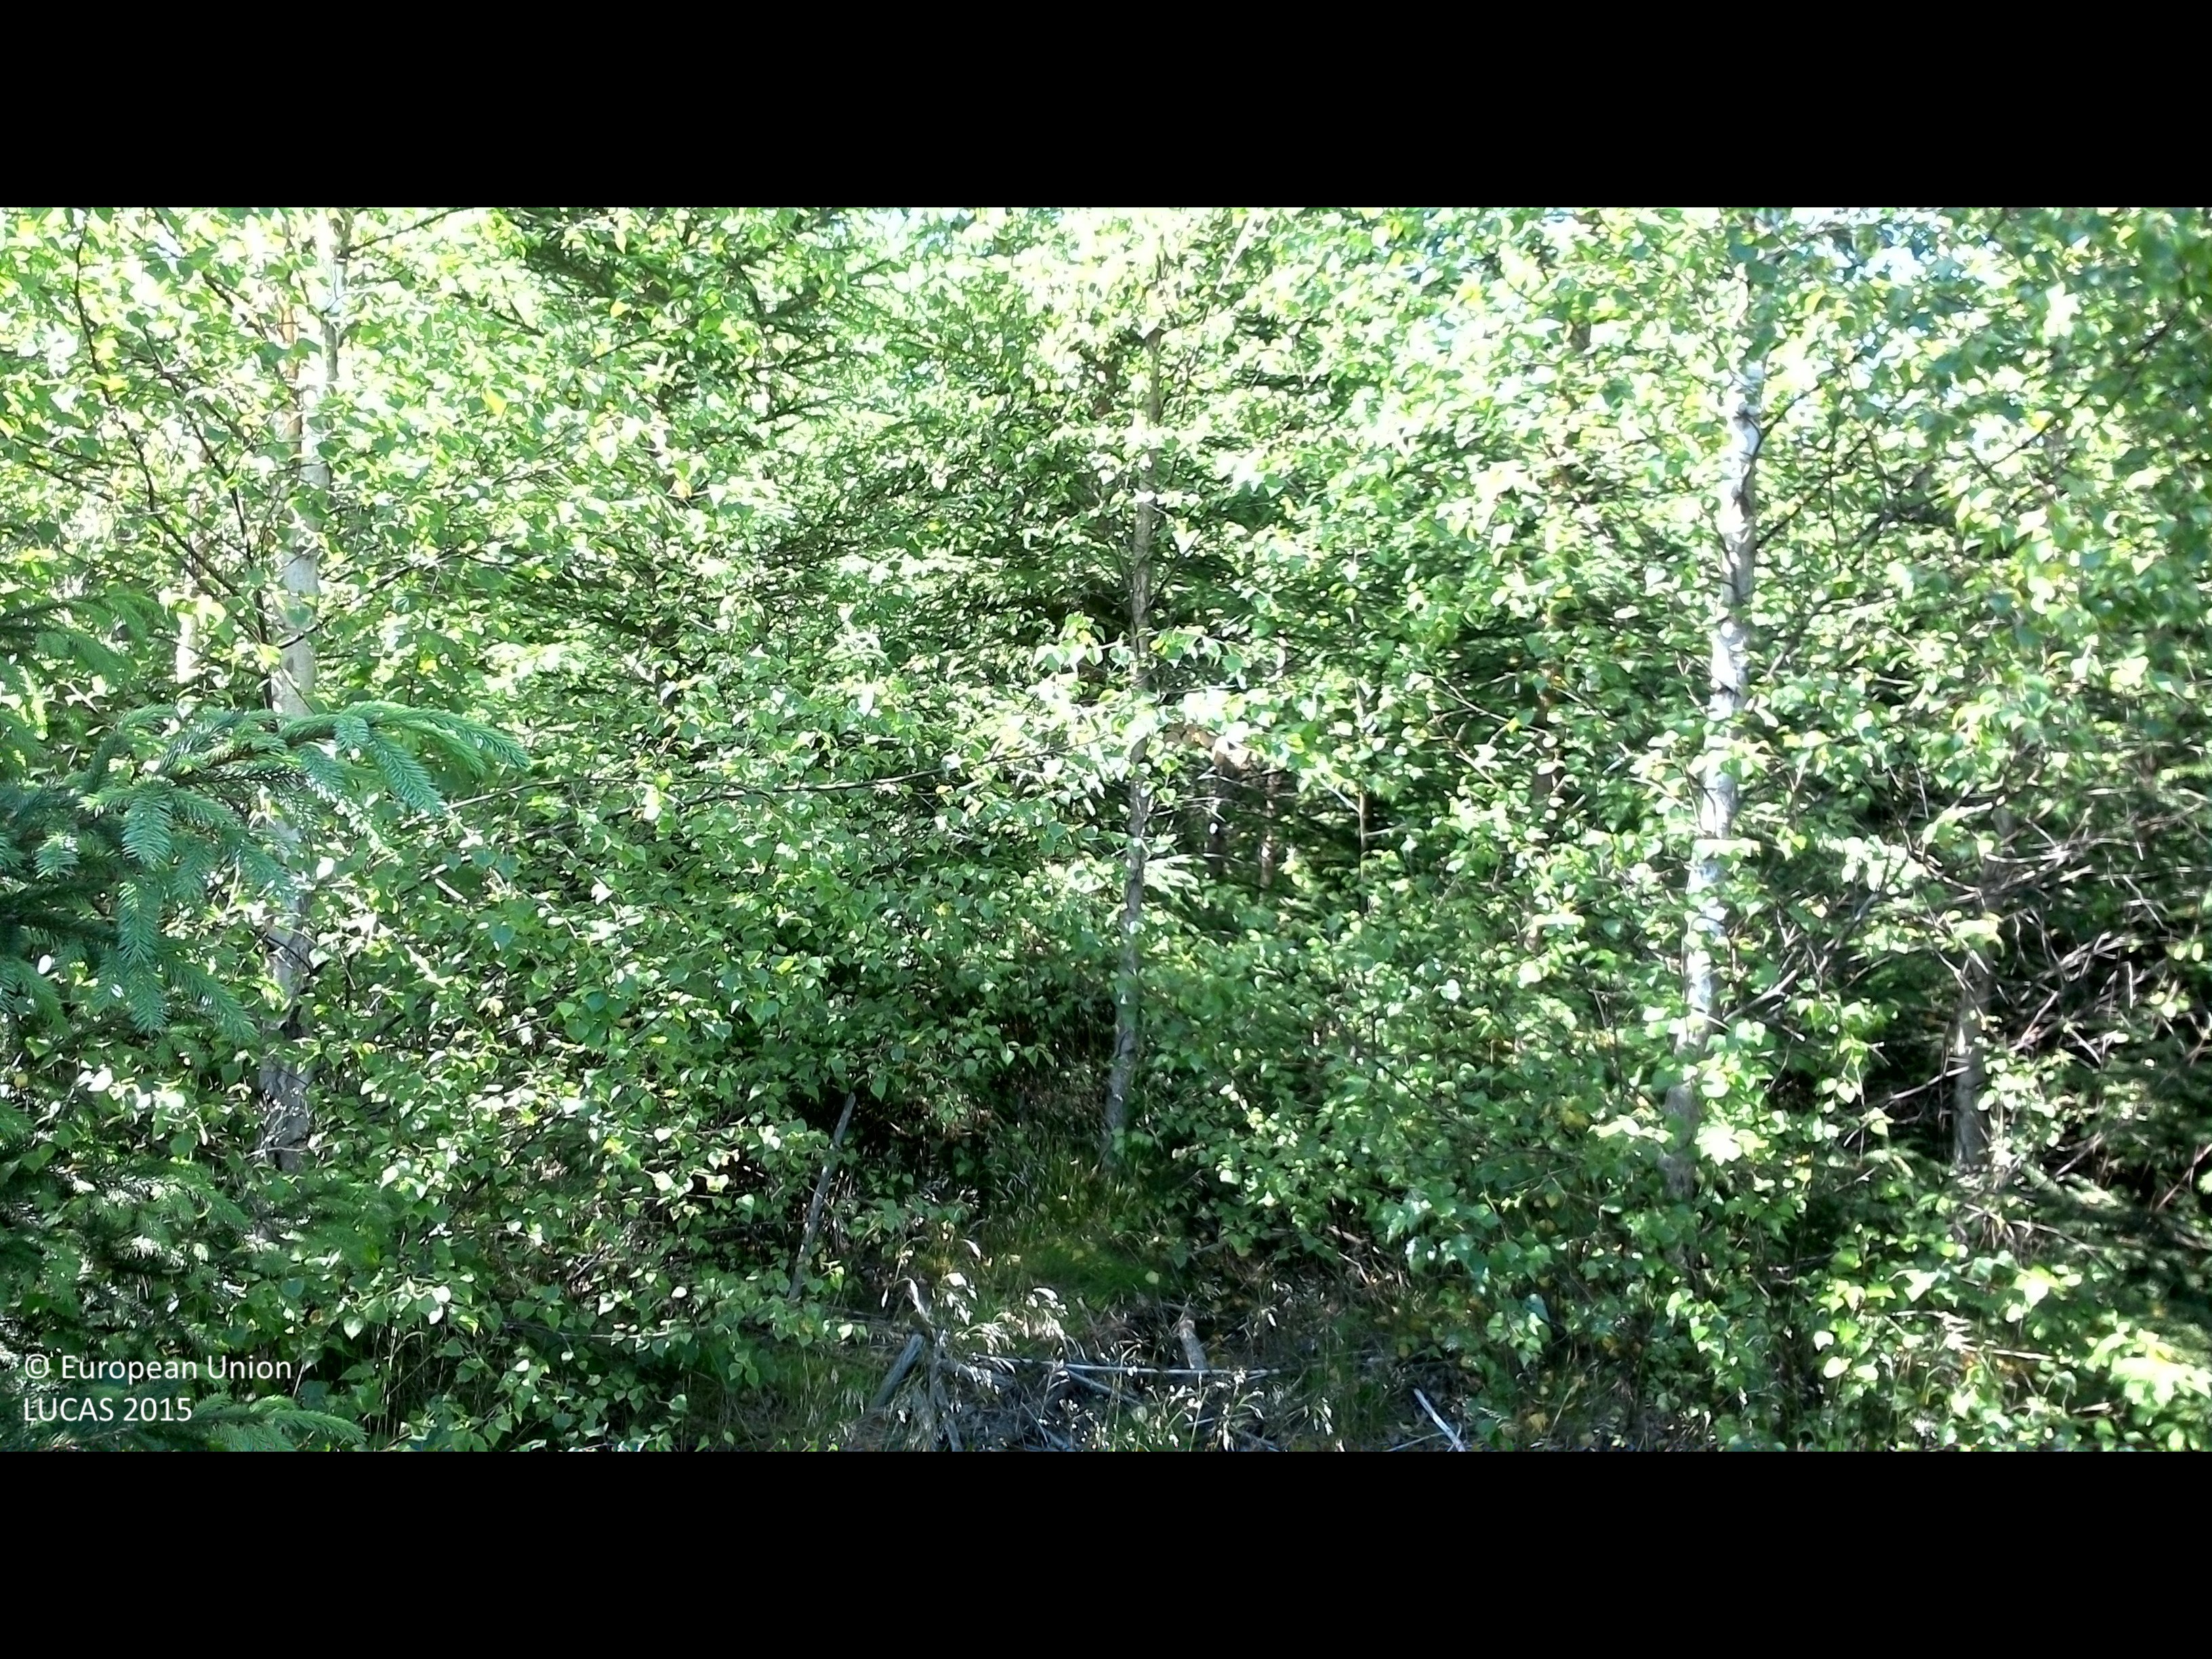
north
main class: Woodland
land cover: Spruce dominated mixed woodland
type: boreal forest
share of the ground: 50 - 75 %
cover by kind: coniferous forest trees 50 %, broadleaved forest trees 25 %, herbaceous plants 25 %
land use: Forestry
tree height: < 5 m
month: July
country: SE
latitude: 56.5652
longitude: 14.8309
